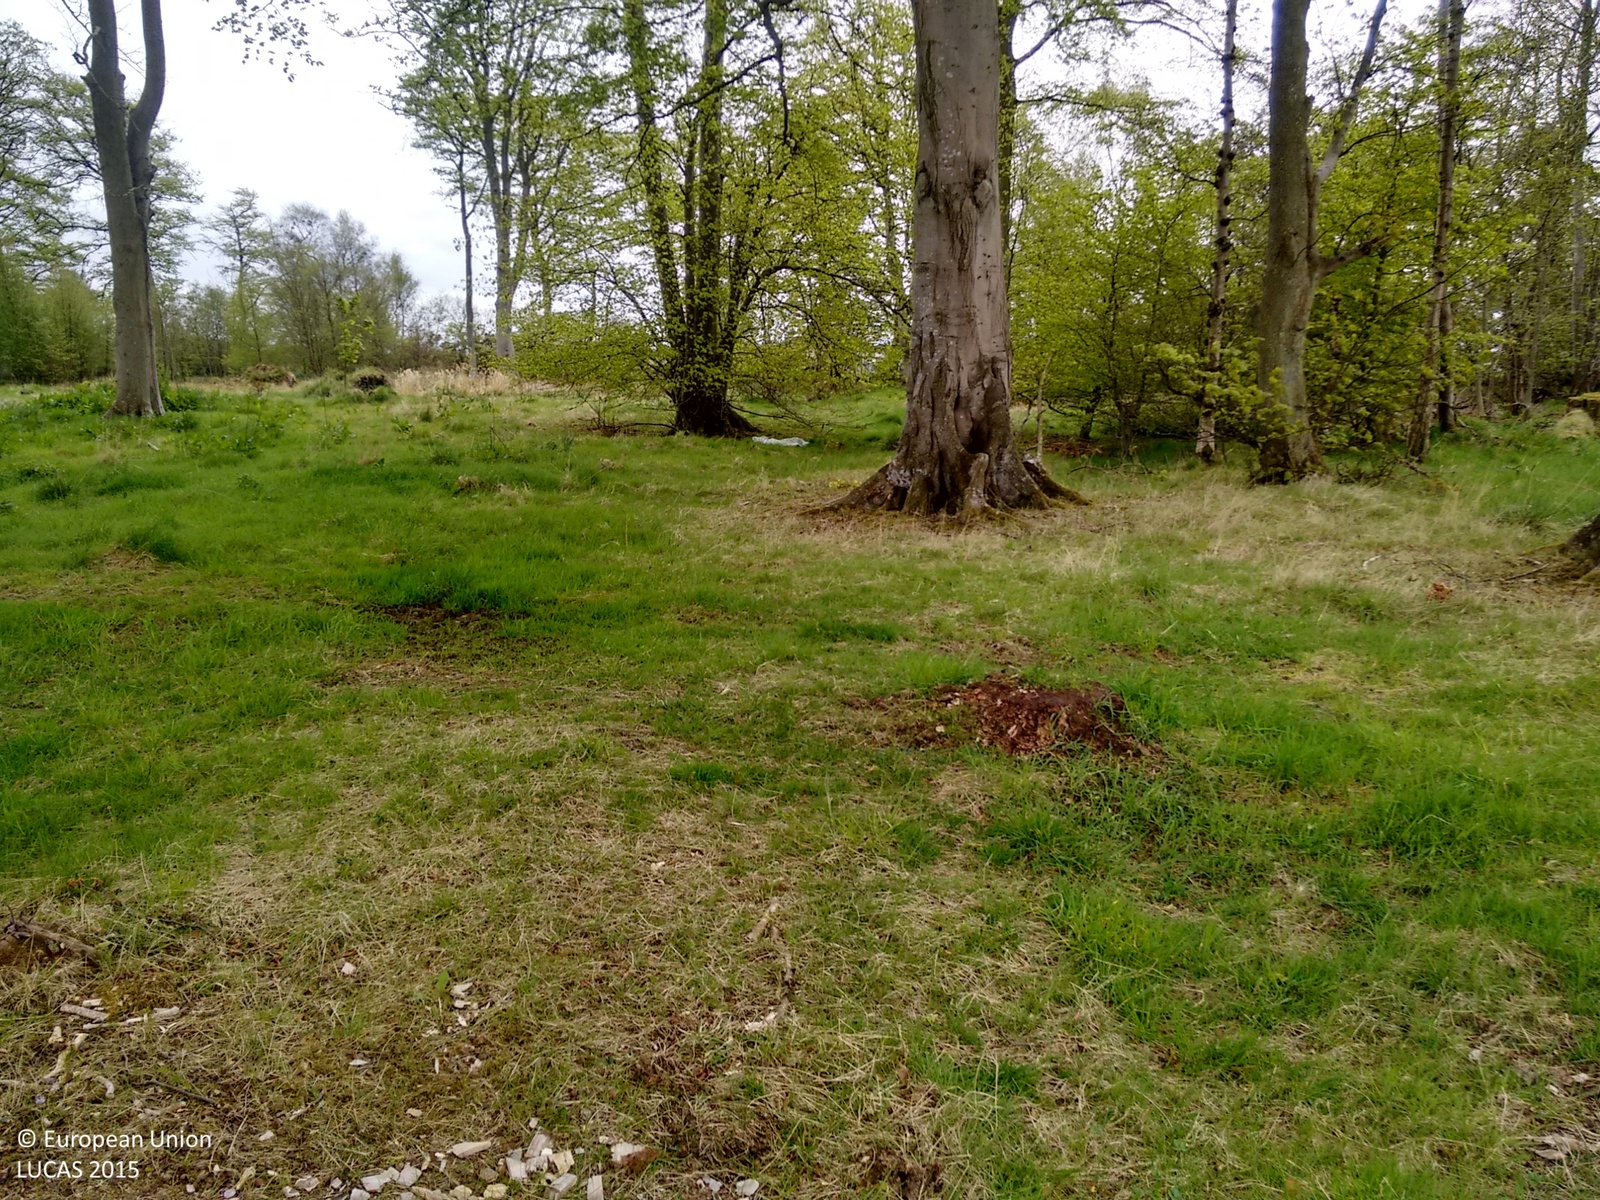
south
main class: Woodland
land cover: Broadleaved woodland
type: exotic forest
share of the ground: > 75 %
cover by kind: broadleaved forest trees 75 %, herbaceous plants 25 %
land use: Semi-natural and natural areas not in use
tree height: > 5 m
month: May
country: GB
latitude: 56.5174
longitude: -2.7218
